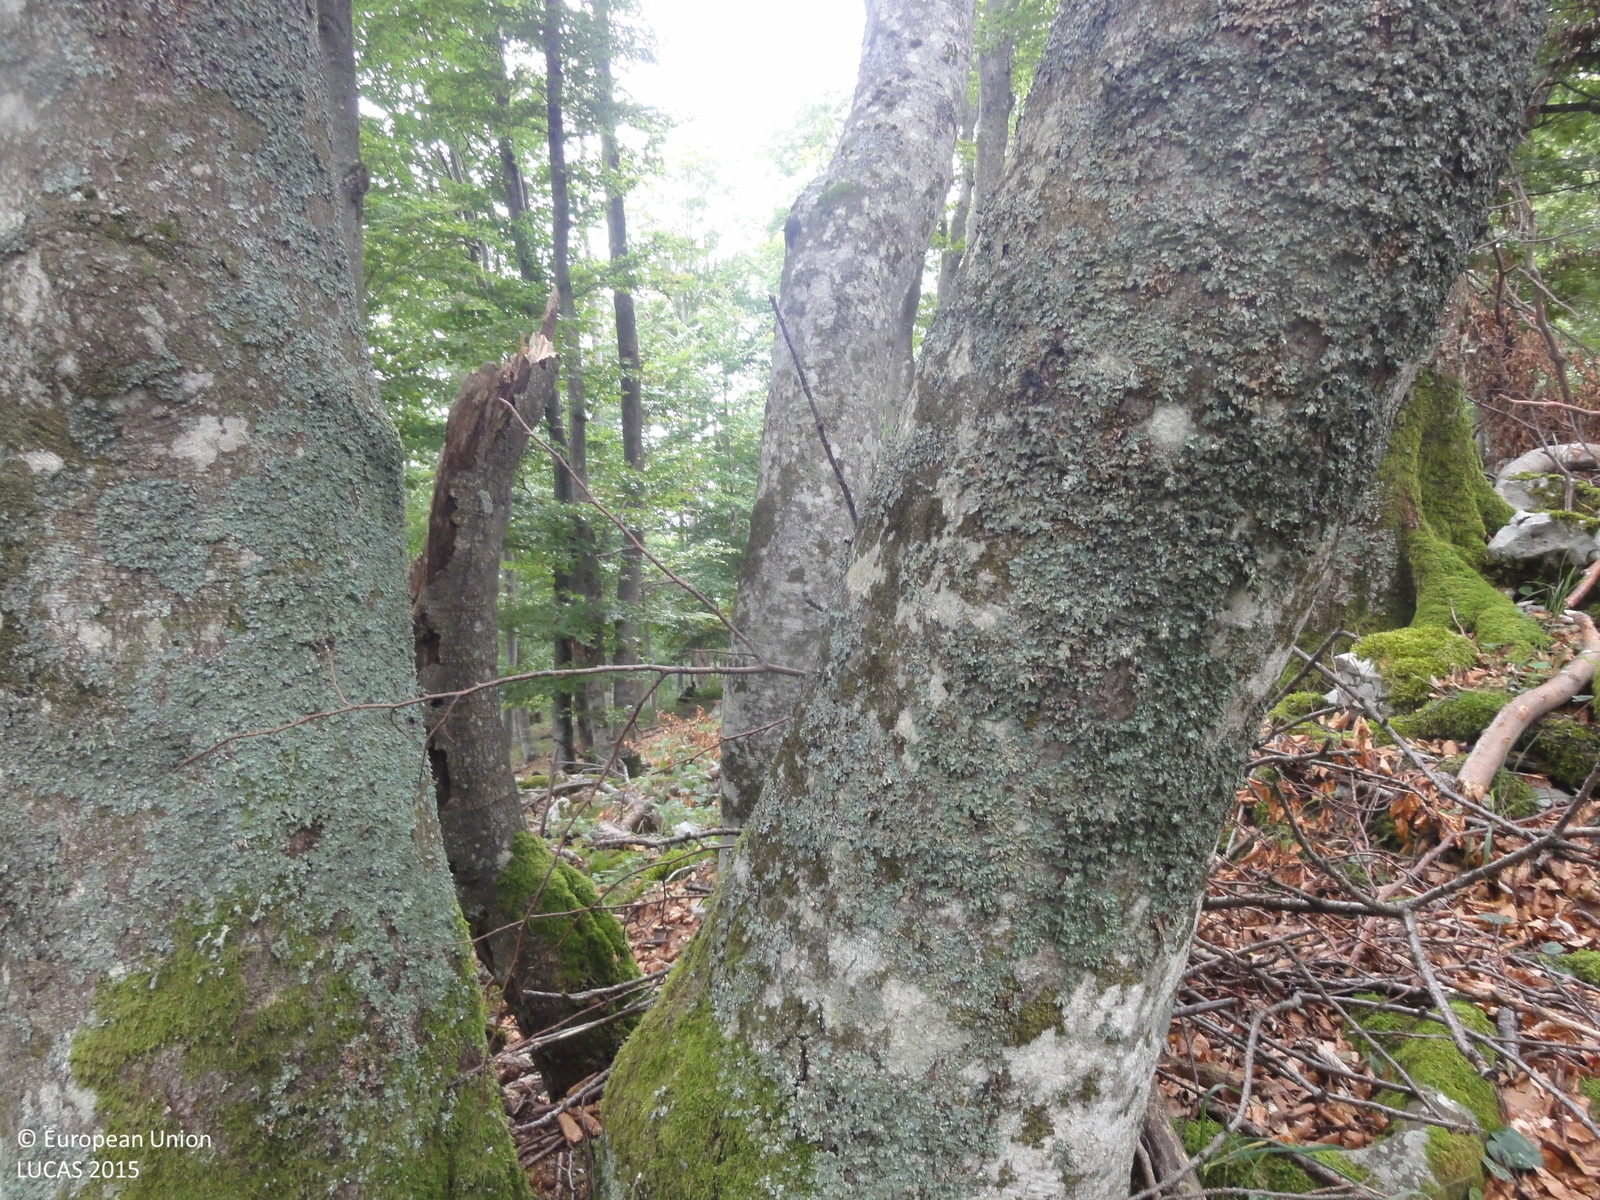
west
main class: Woodland
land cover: Broadleaved woodland
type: mountainous beech forest
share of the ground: > 75 %
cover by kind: broadleaved forest trees 95 %, consolidated bare surface 5 %
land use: Forestry
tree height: > 5 m
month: September
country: SI
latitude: 45.6034
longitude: 14.9833
